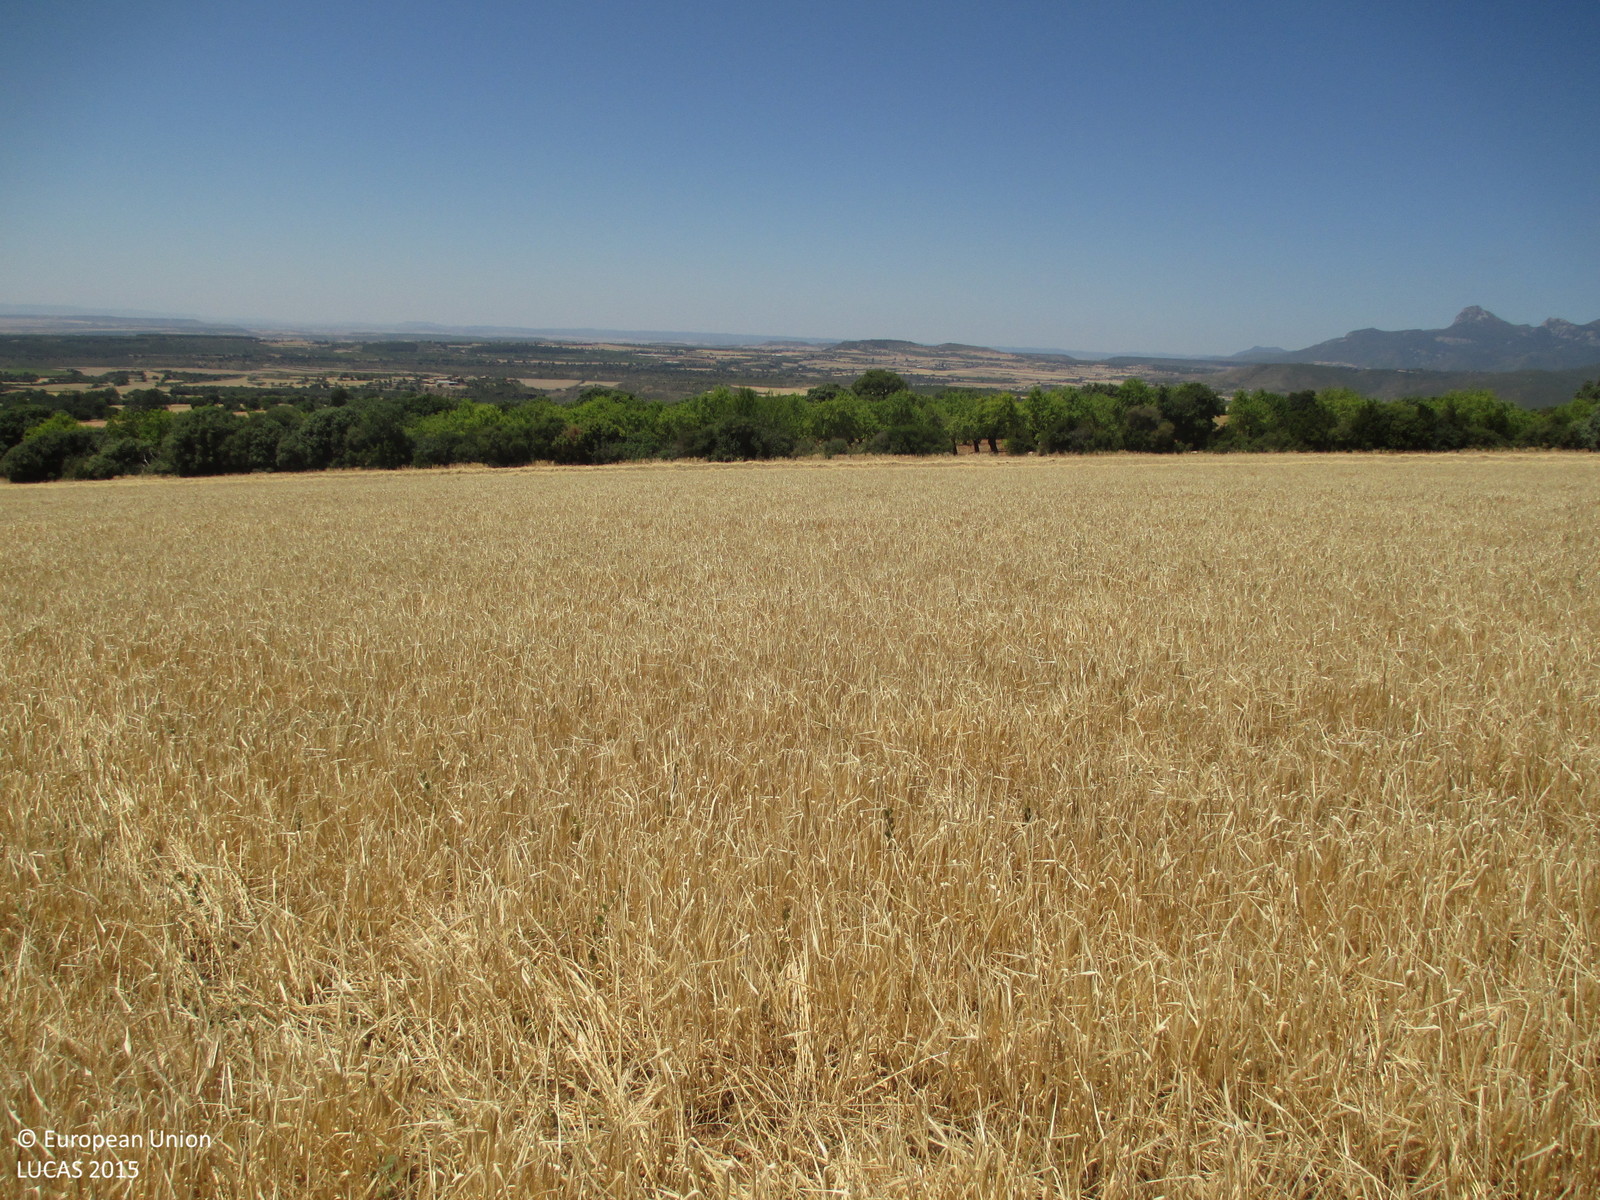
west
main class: Cropland
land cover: Barley
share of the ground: > 75 %
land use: Agriculture (excluding fallow land and kitchen gardens)
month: June
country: ES
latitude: 42.2153
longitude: -0.3314
